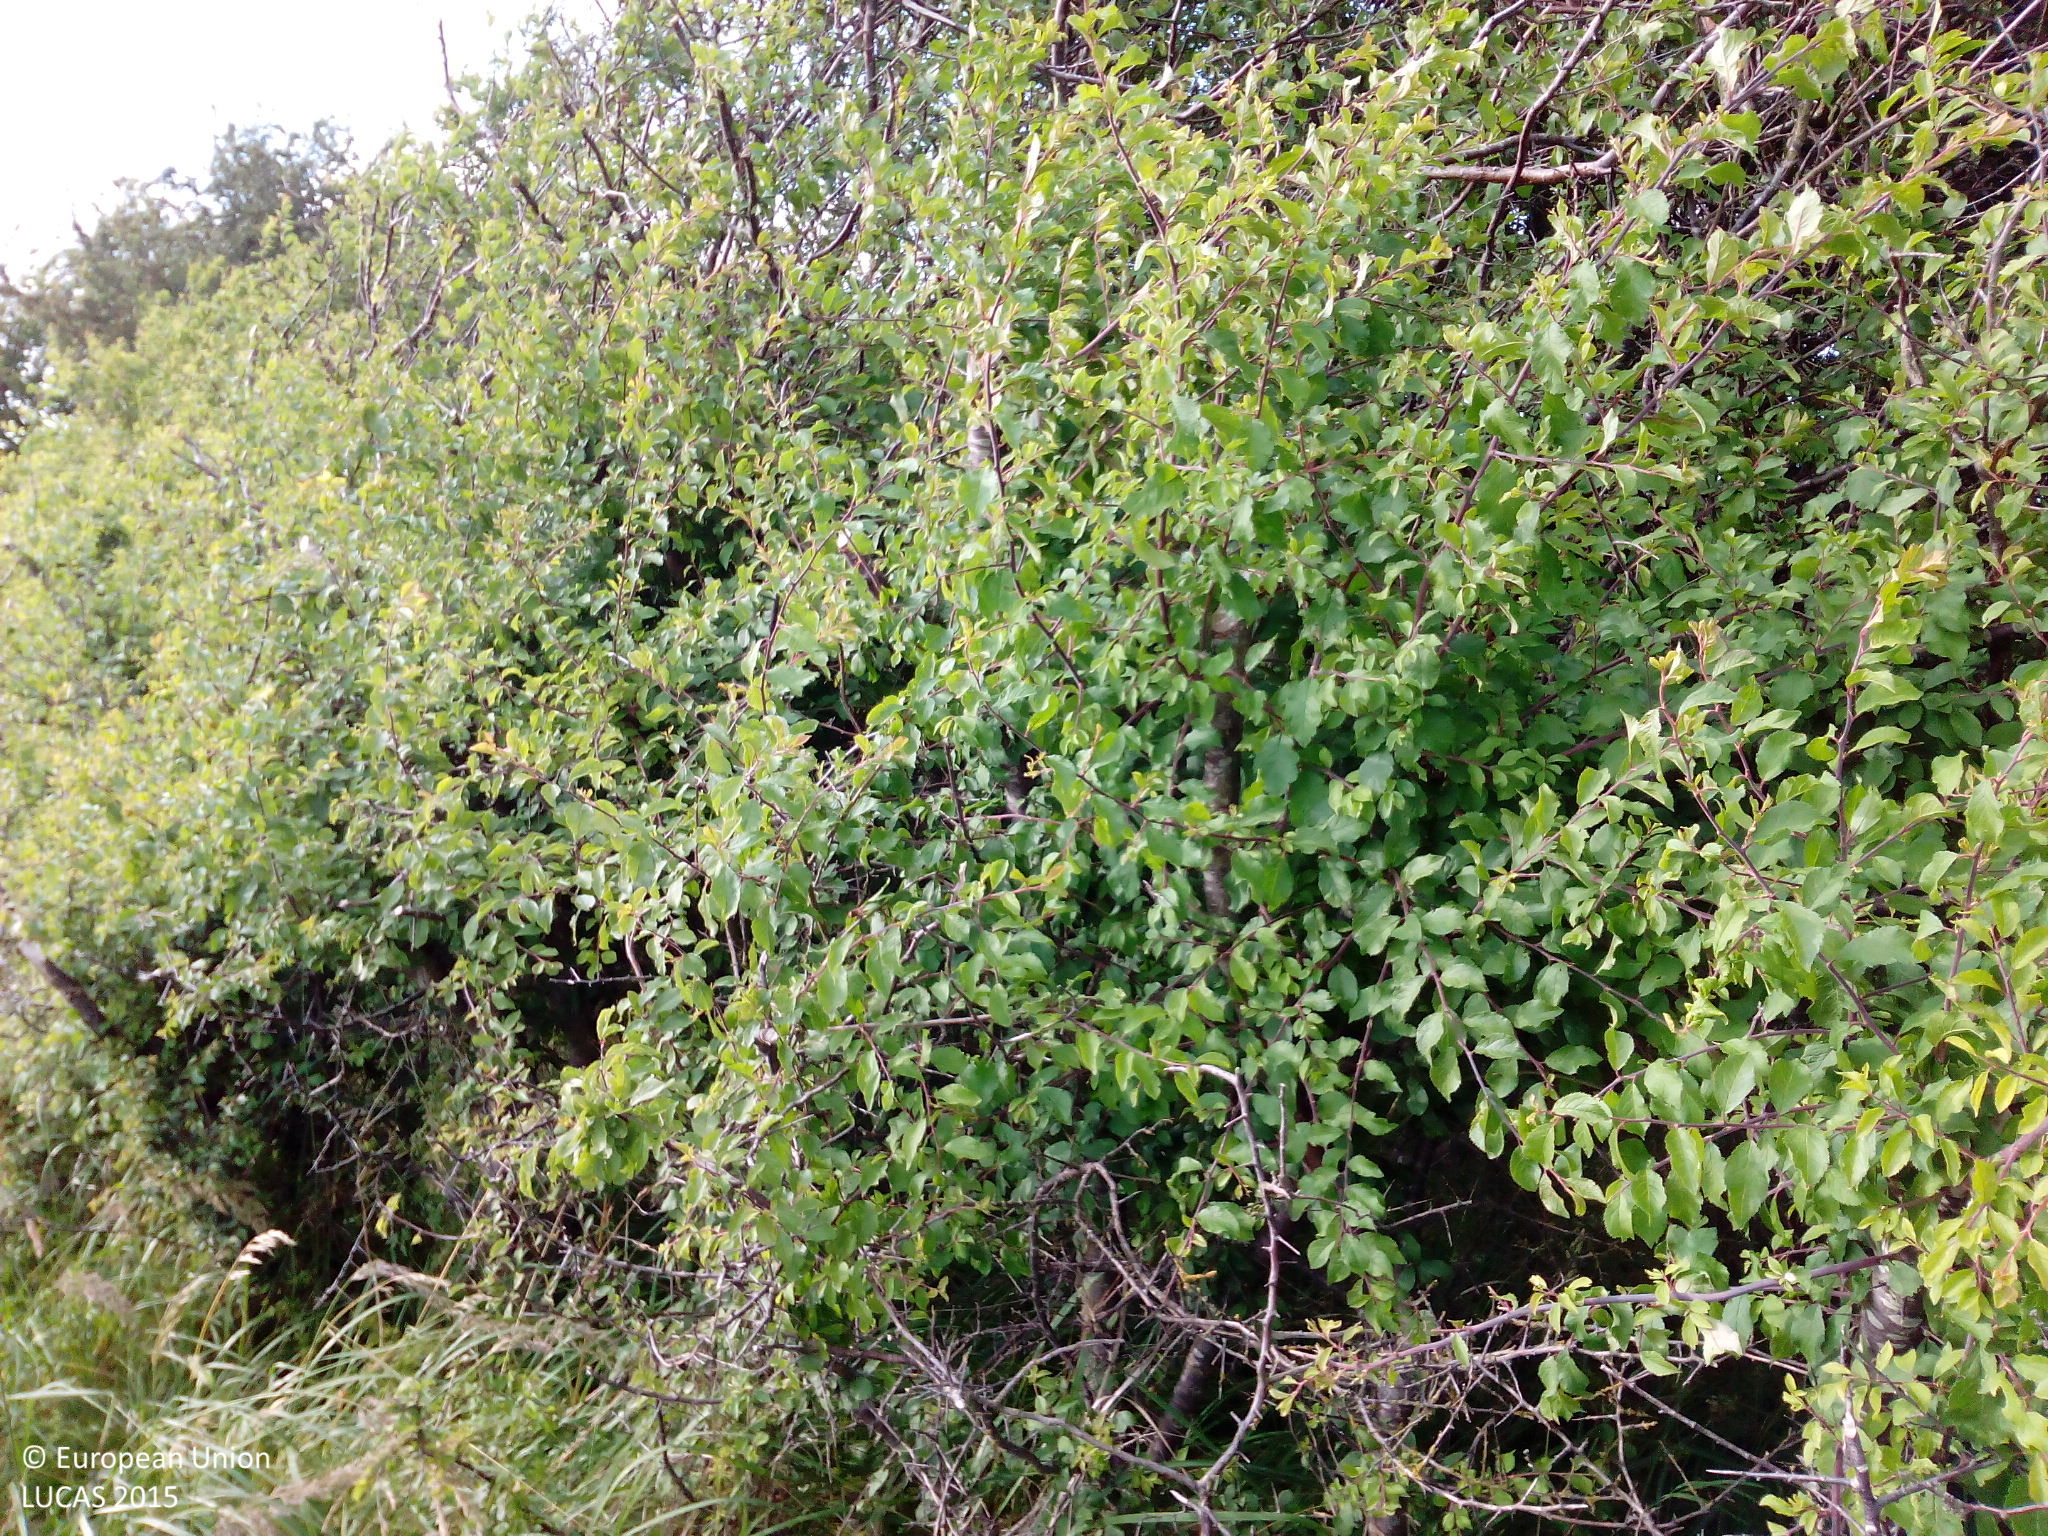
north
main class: Cropland
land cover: Barley
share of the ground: > 75 %
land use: Agriculture (excluding fallow land and kitchen gardens)
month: July
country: DK
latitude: 55.8372
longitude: 11.5154
